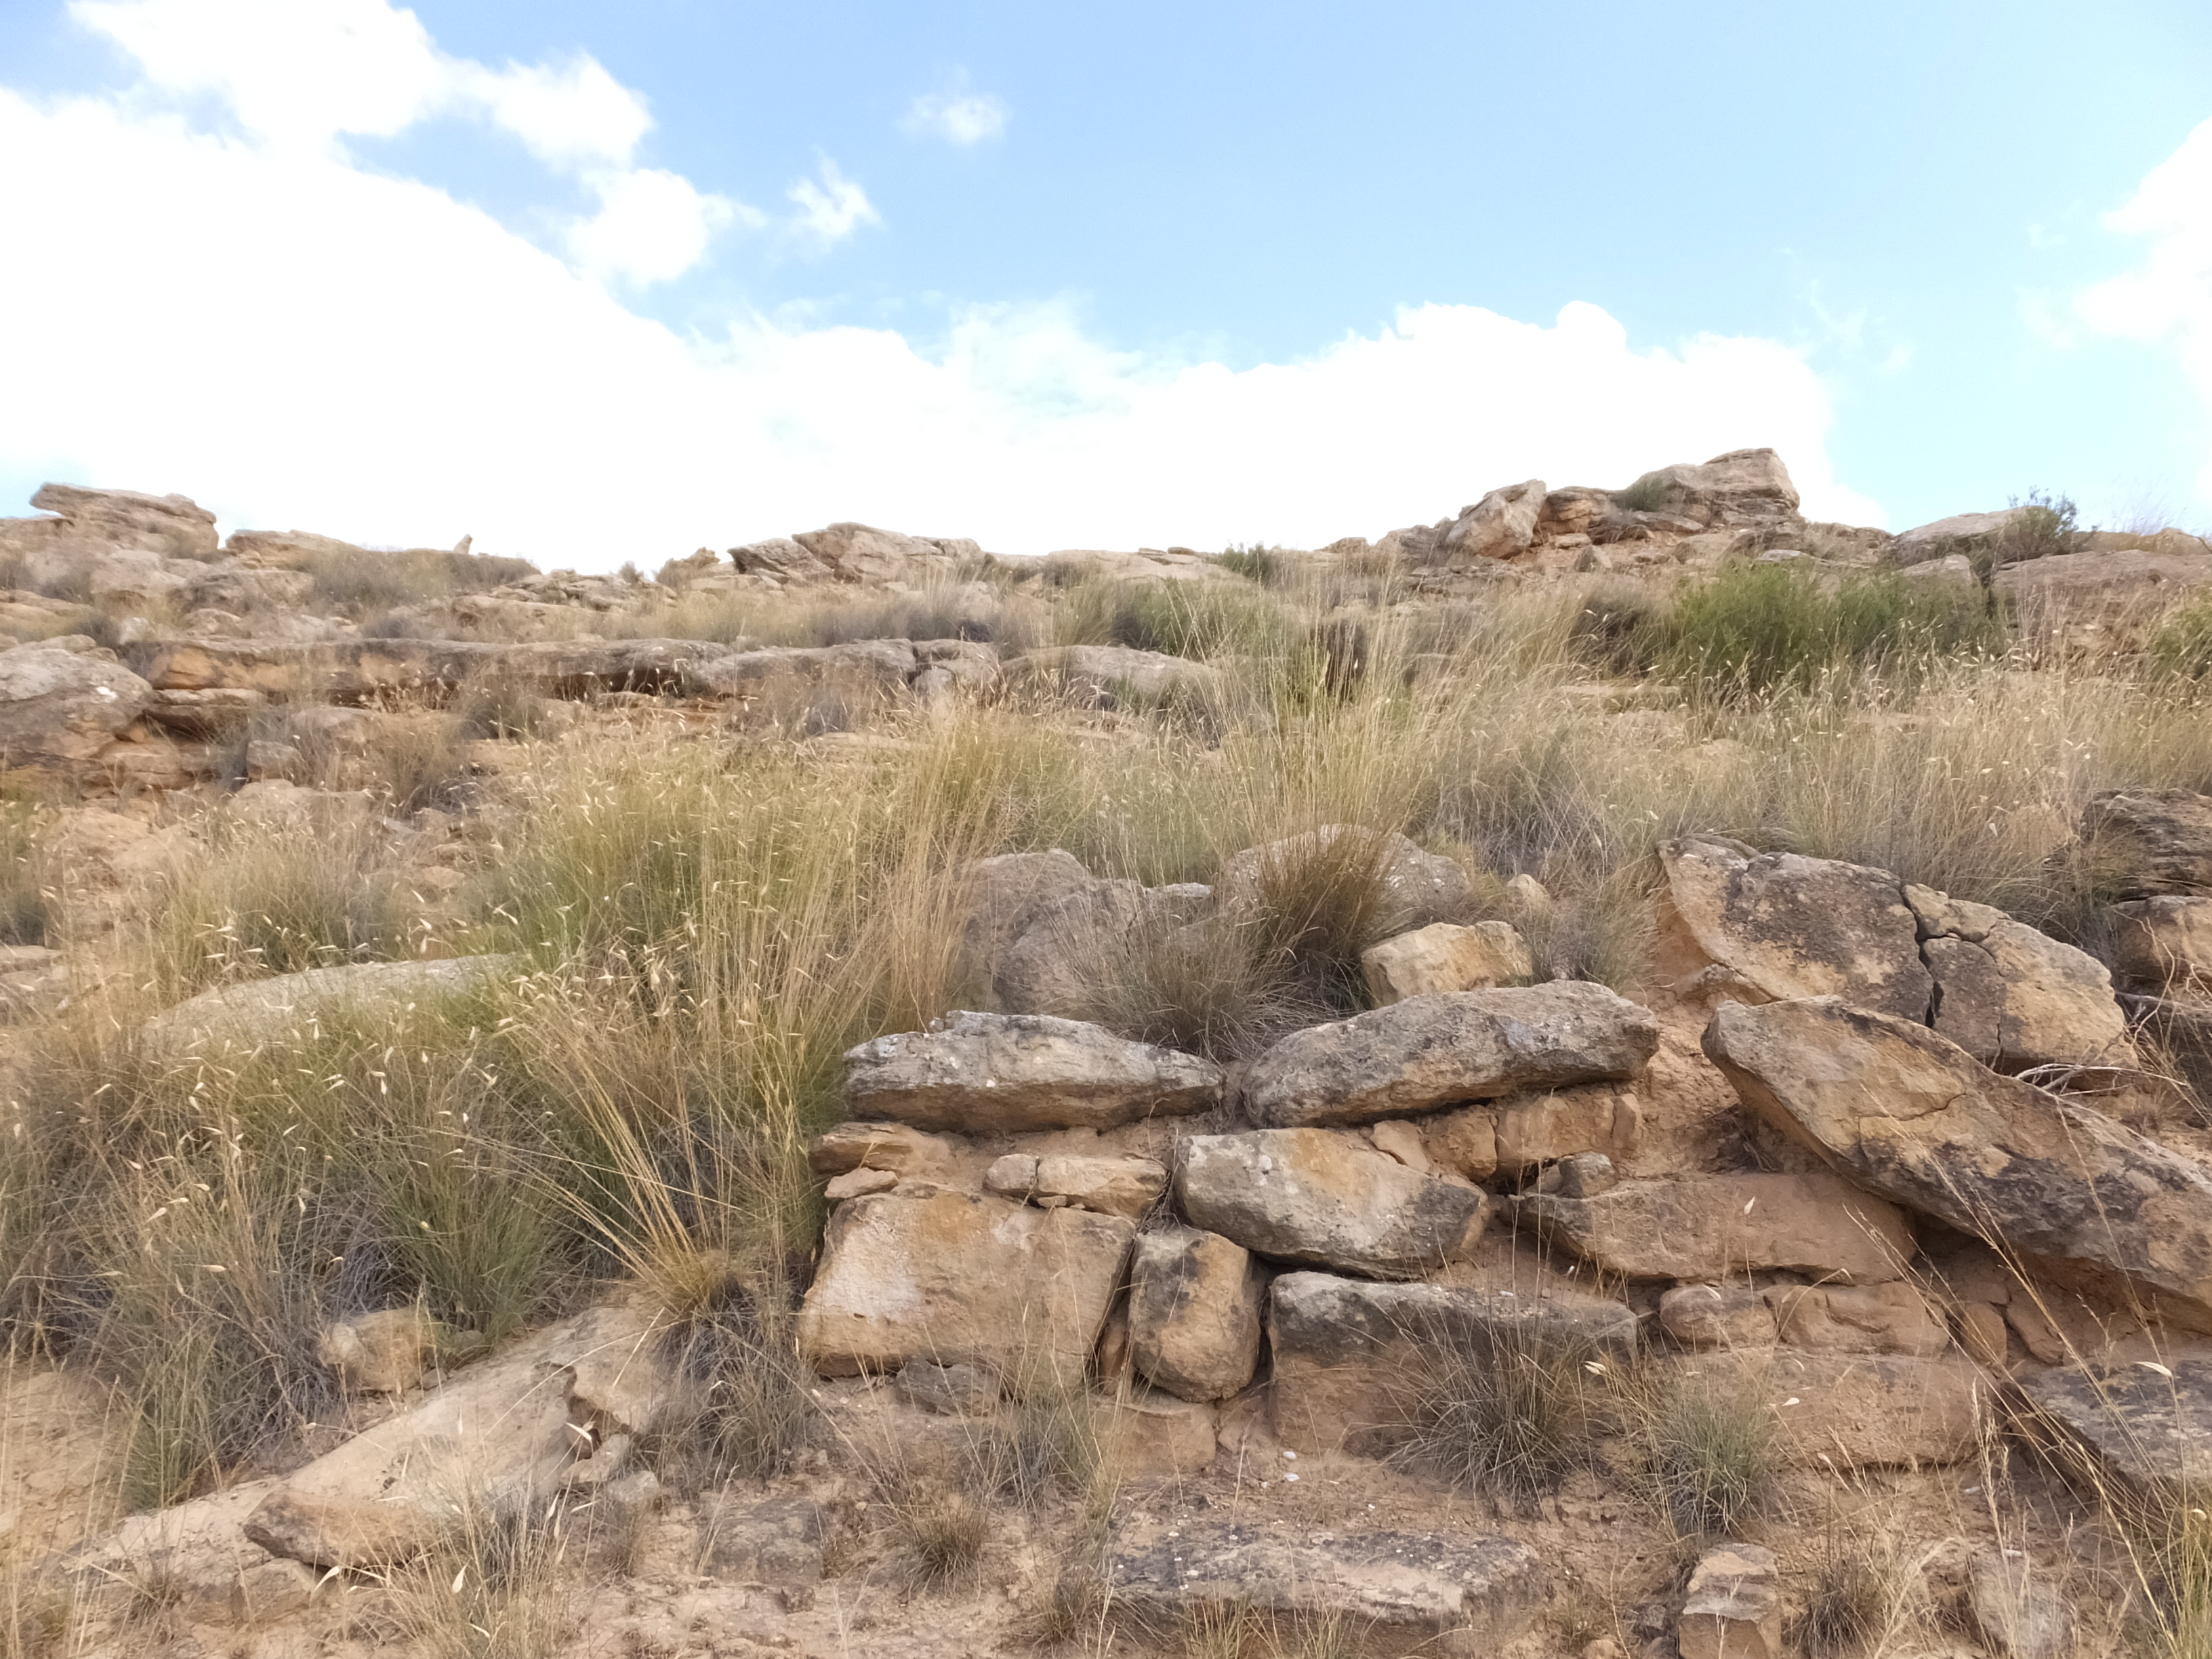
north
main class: Shrubland
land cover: Shrubland without tree cover
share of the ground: 50 - 75 %
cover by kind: herbaceous plants 50 %, shrubs 25 %, lichens and mosses 25 %
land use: Semi-natural and natural areas not in use
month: June
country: ES
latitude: 41.3151
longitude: -0.0595
